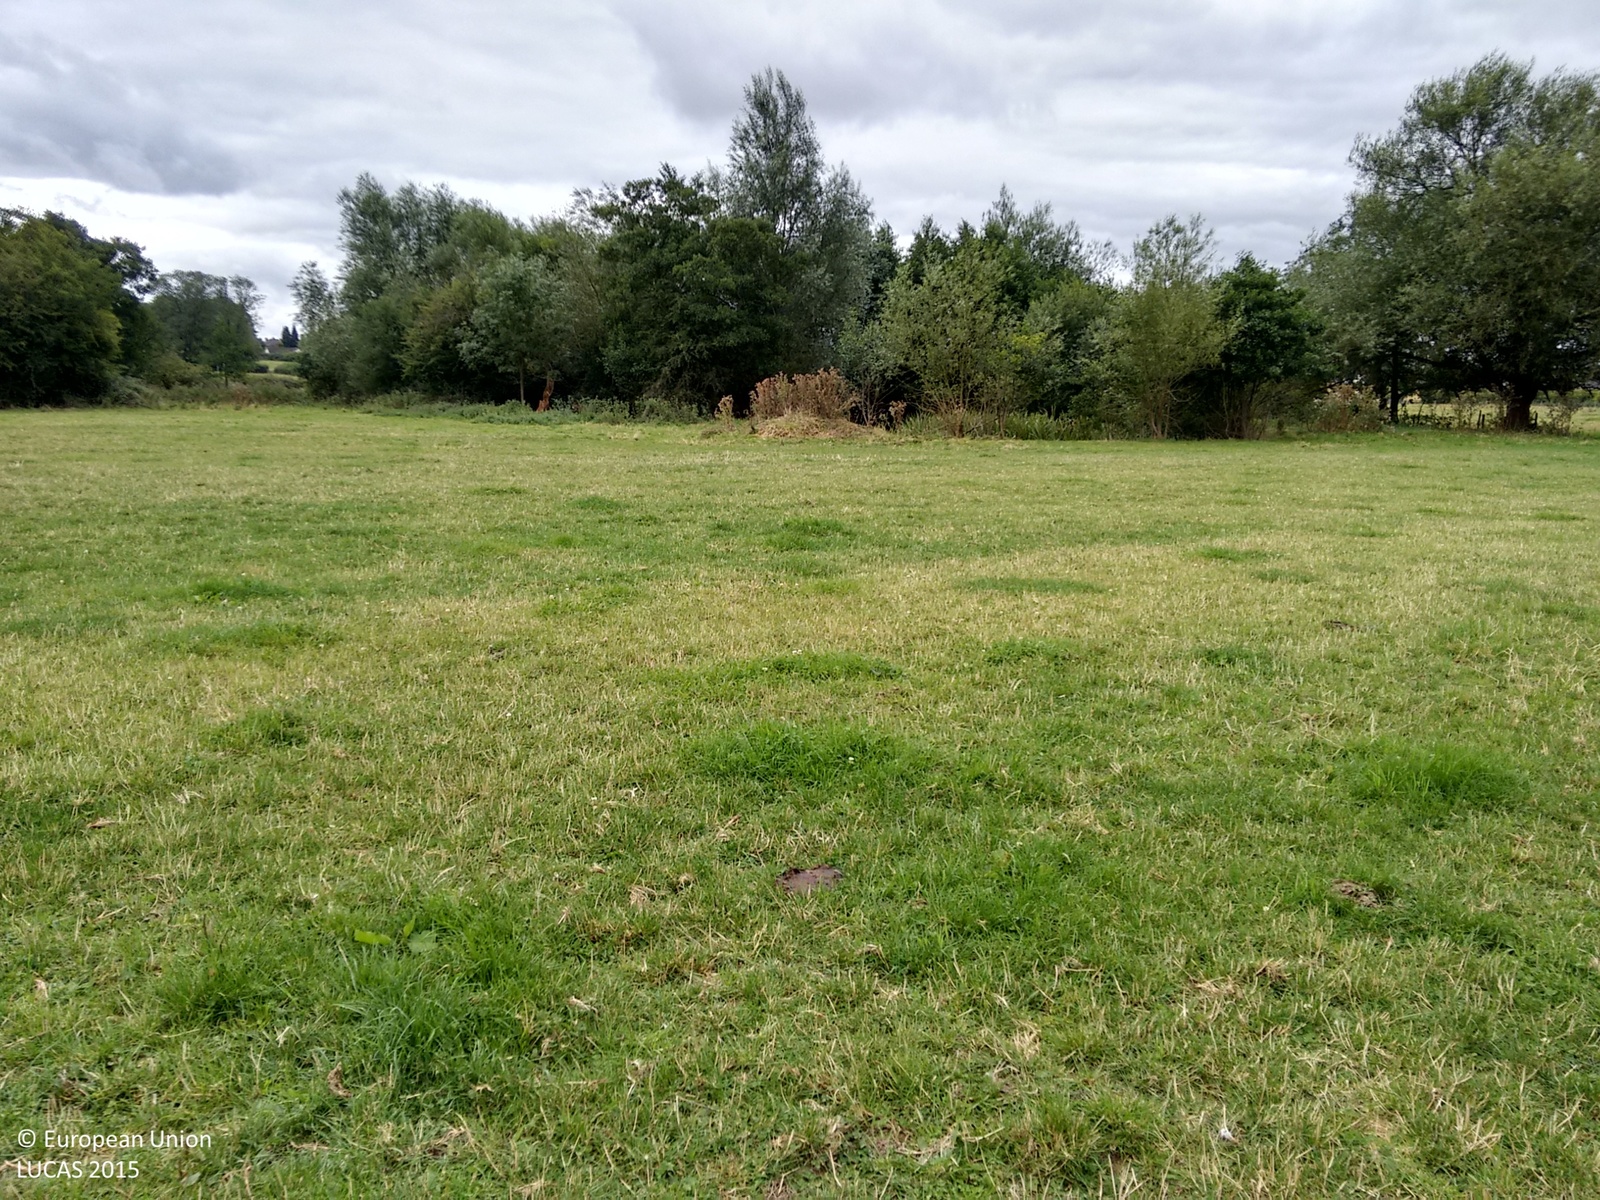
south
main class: Grassland
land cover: Grassland without tree/shrub cover
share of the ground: > 75 %
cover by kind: herbaceous plants 100 %
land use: Agriculture (excluding fallow land and kitchen gardens)
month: August
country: GB
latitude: 52.6412
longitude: -1.2343
